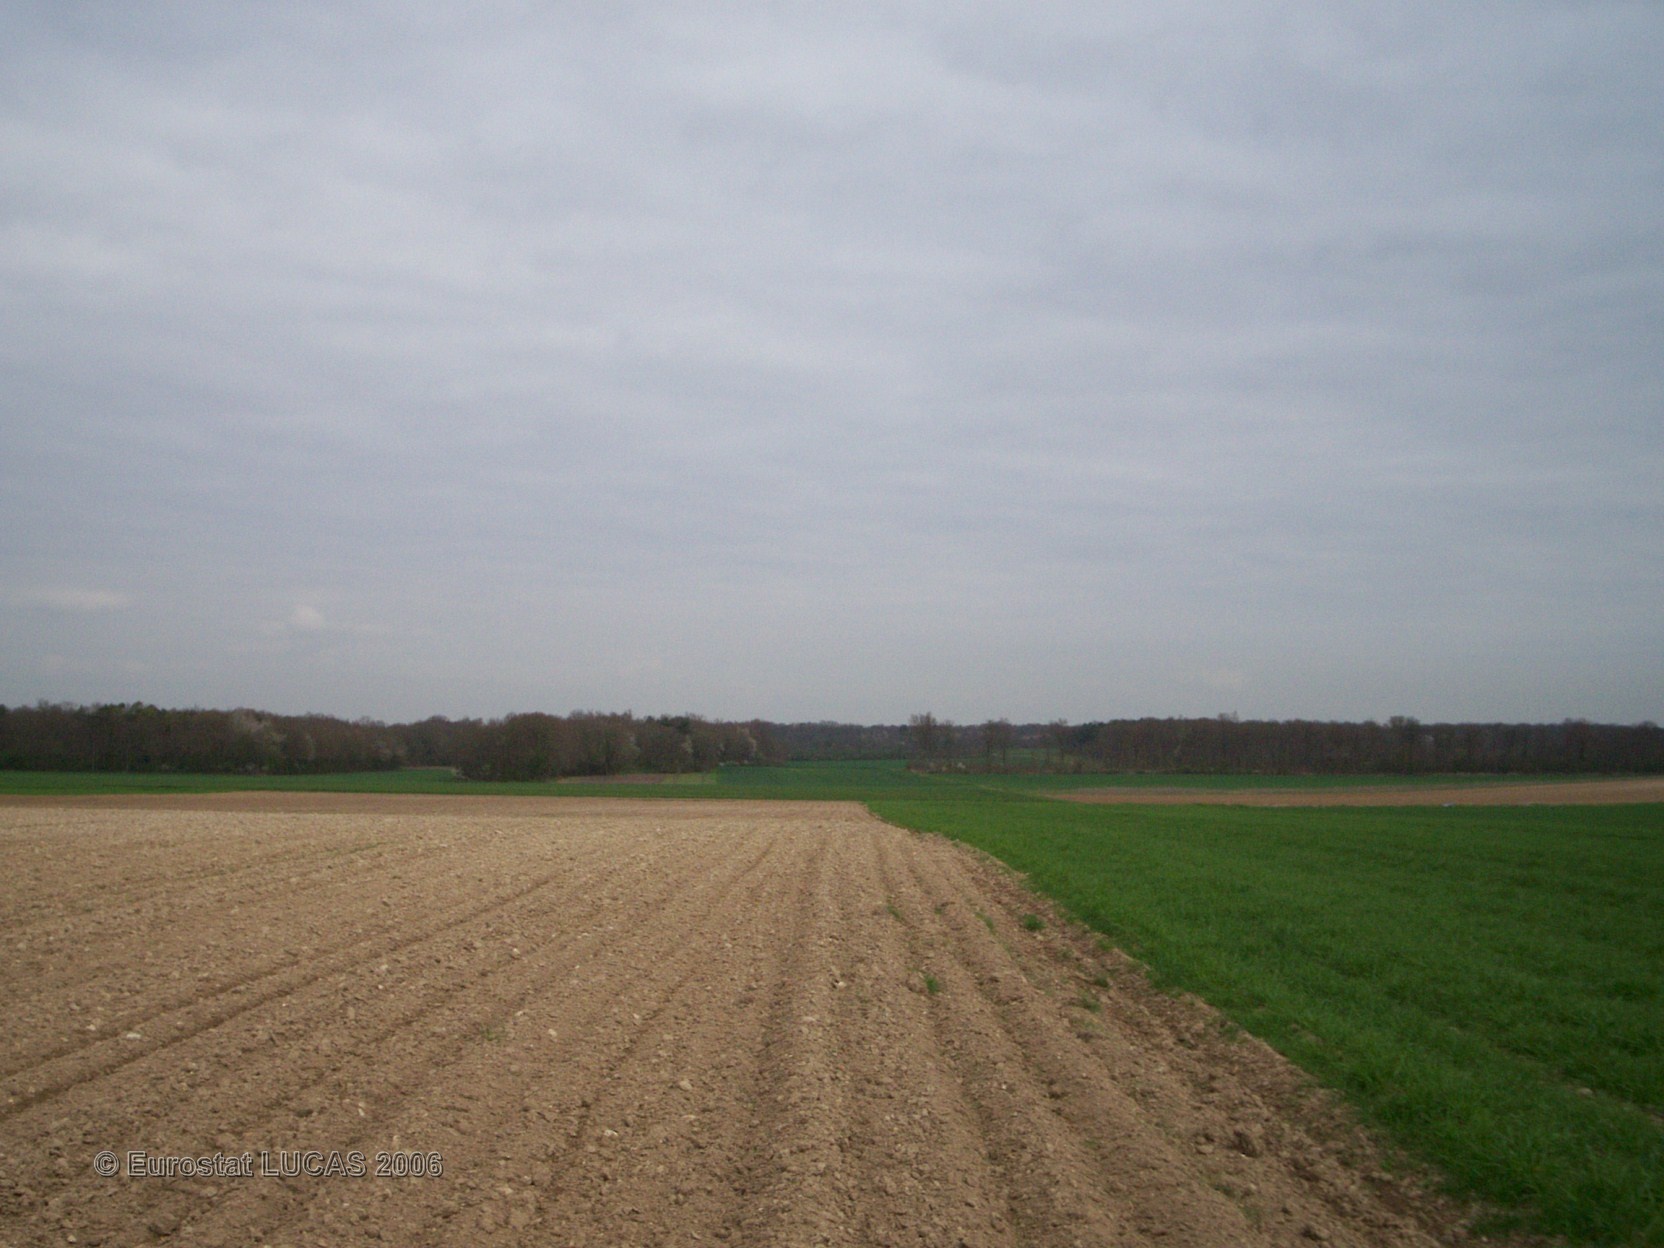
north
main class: Cropland
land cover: Sunflower
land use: Agriculture (excluding fallow land and kitchen gardens)
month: May
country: FR
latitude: 48.2794
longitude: 2.8361
